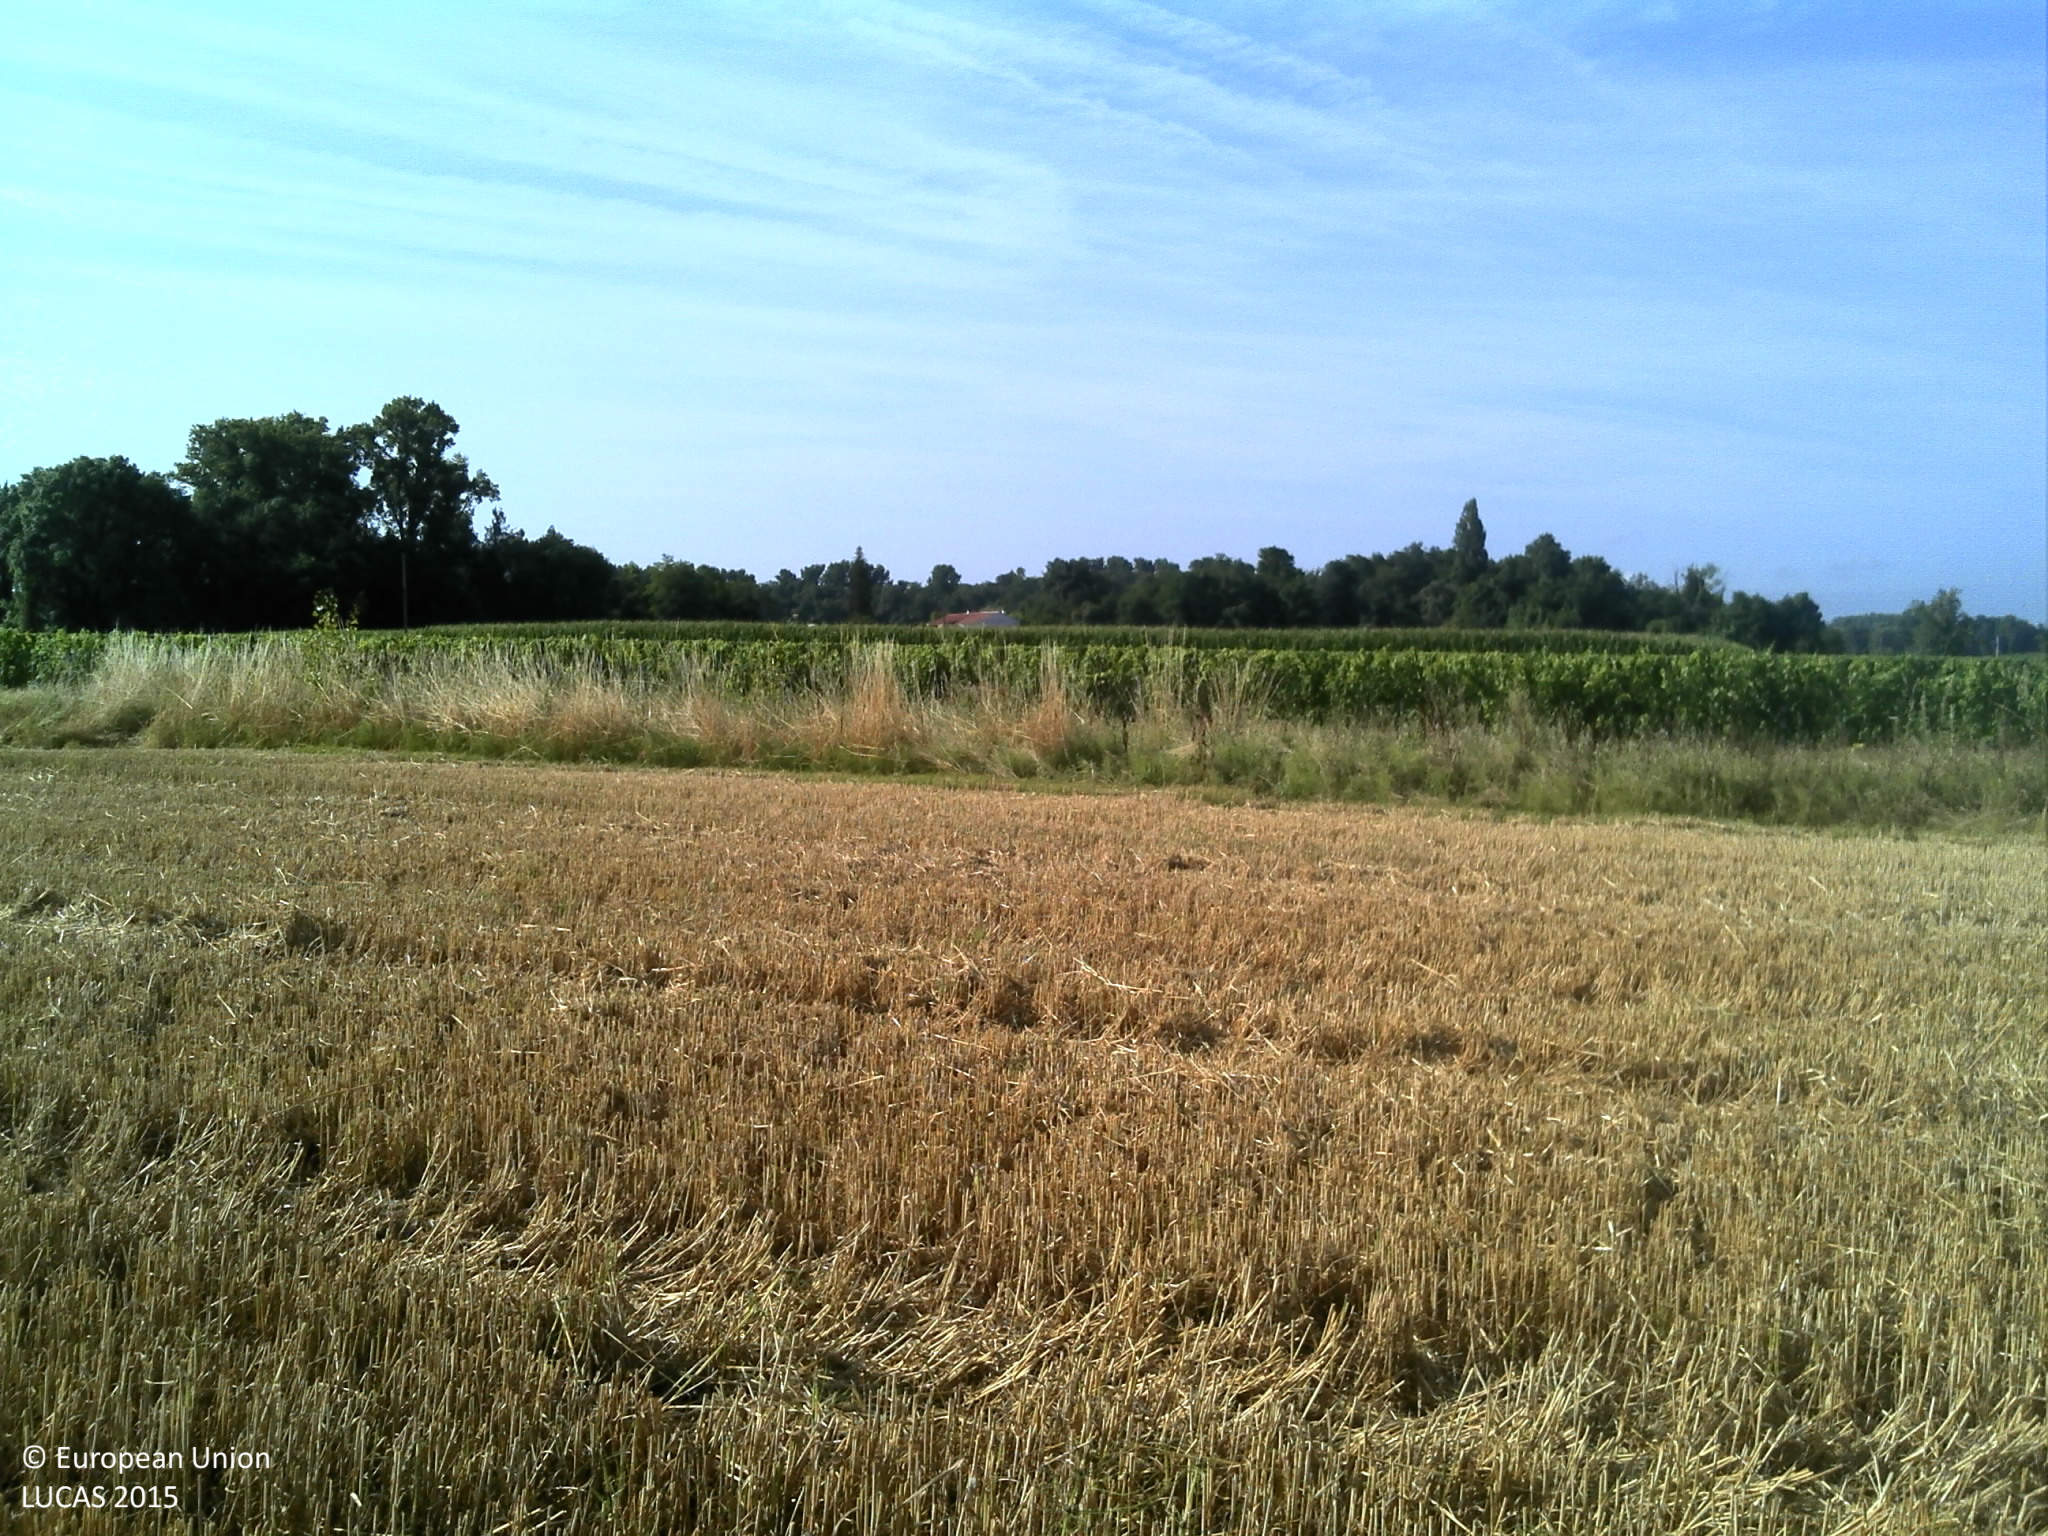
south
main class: Cropland
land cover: Common wheat
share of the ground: > 75 %
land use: Agriculture (excluding fallow land and kitchen gardens)
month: July
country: FR
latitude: 44.6985
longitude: -0.4023
